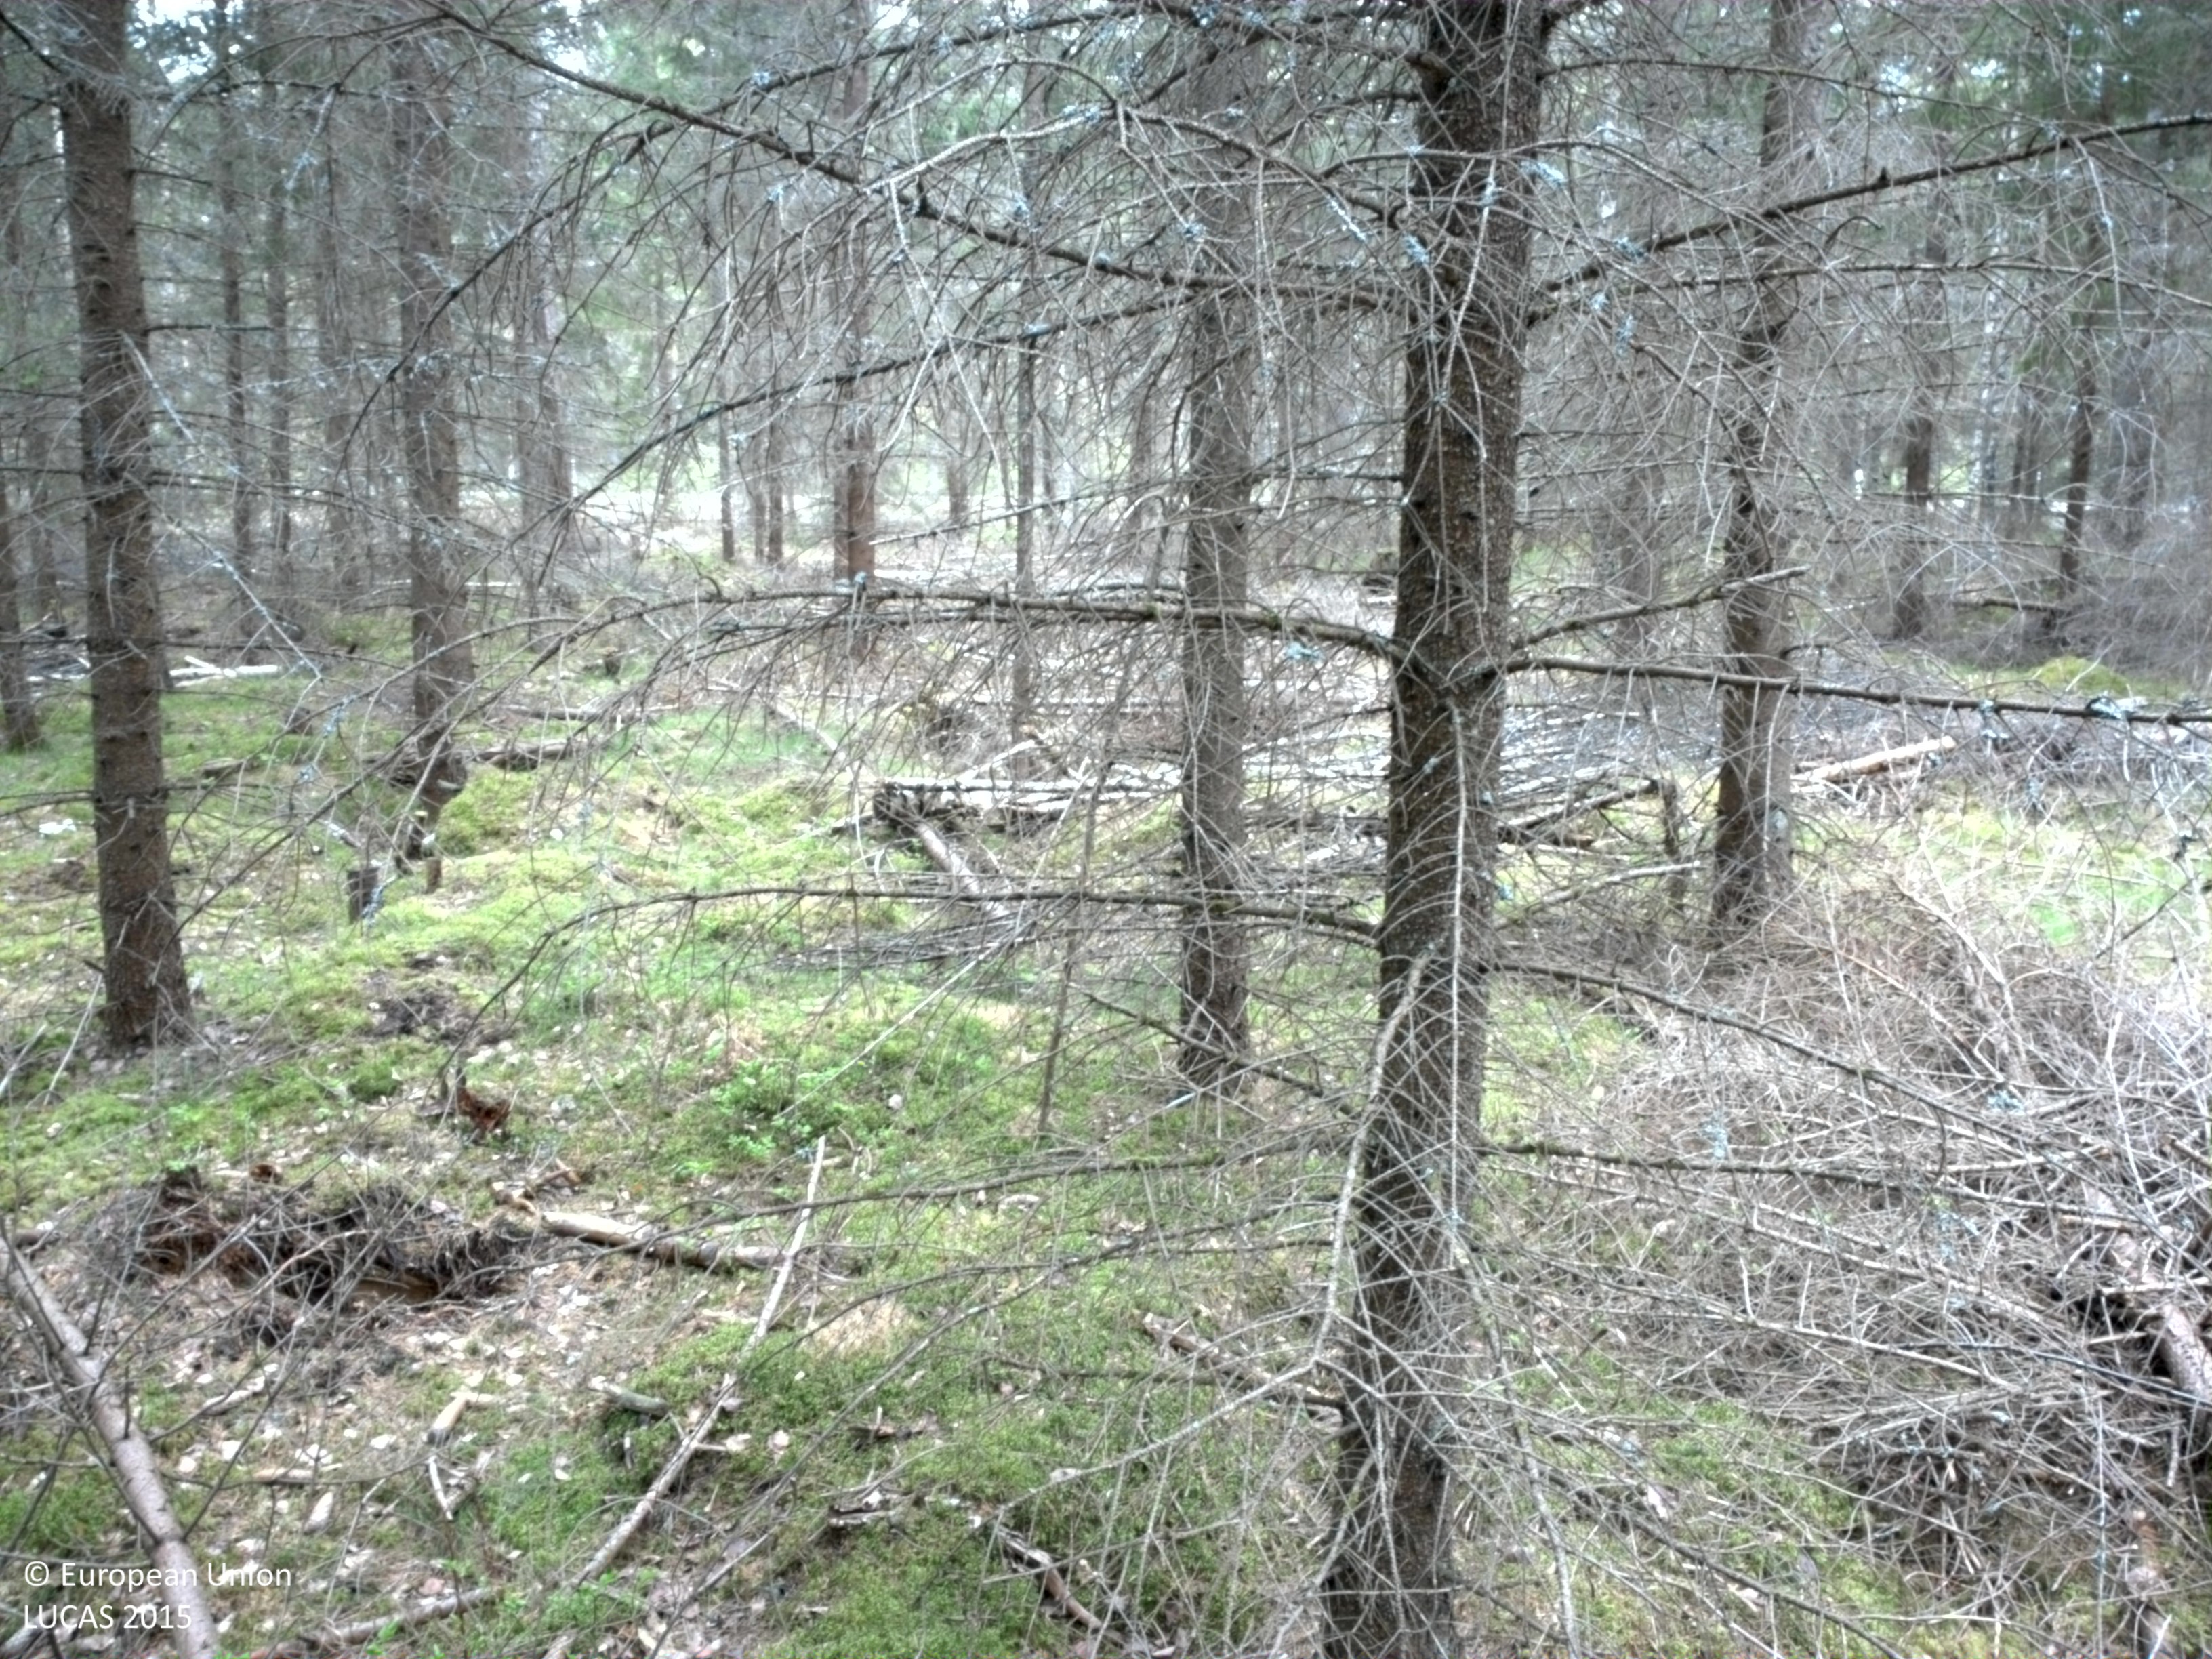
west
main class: Woodland
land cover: Spruce dominated coniferous woodland
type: boreal forest
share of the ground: > 75 %
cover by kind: coniferous forest trees 90 %, broadleaved forest trees 5 %, lichens and mosses 5 %
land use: Forestry
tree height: > 5 m
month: May
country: SE
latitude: 56.4167
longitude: 15.3968
